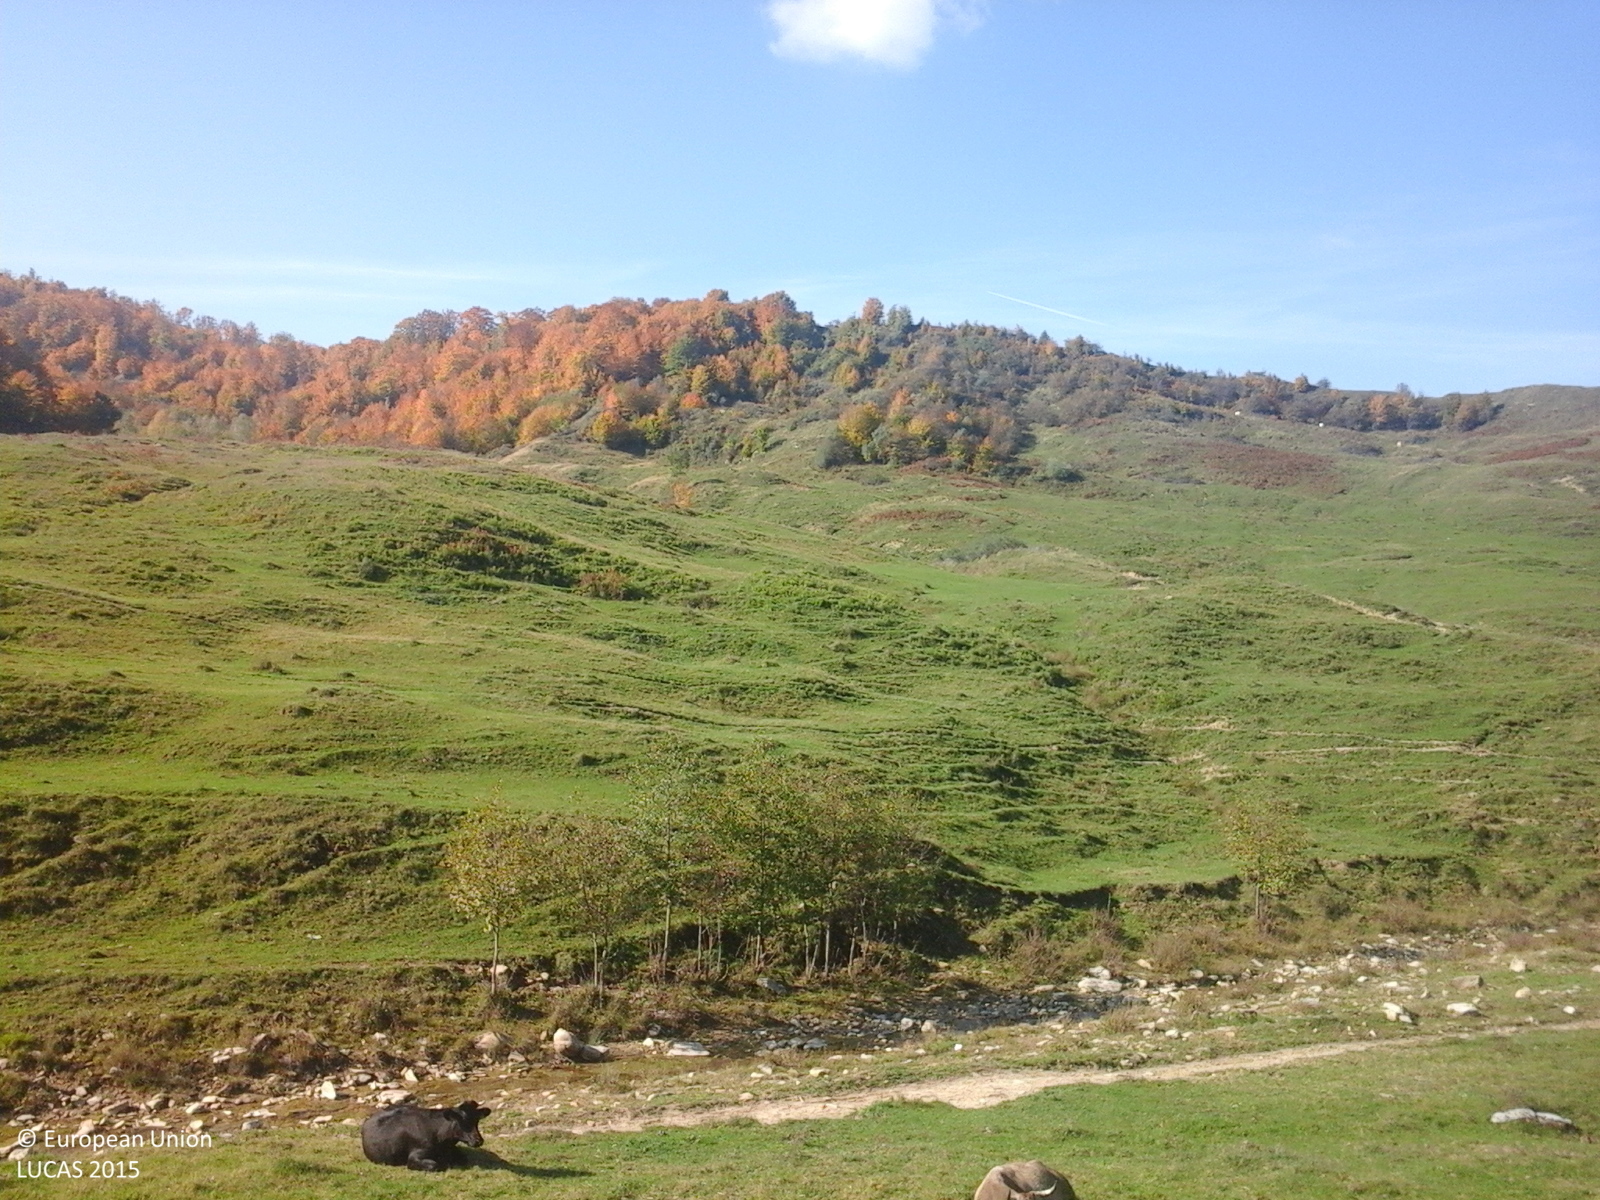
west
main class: Grassland
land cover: Grassland without tree/shrub cover
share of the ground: > 75 %
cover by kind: herbaceous plants 100 %
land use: Agriculture (excluding fallow land and kitchen gardens)
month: October
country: RO
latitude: 46.0311
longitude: 26.7384
